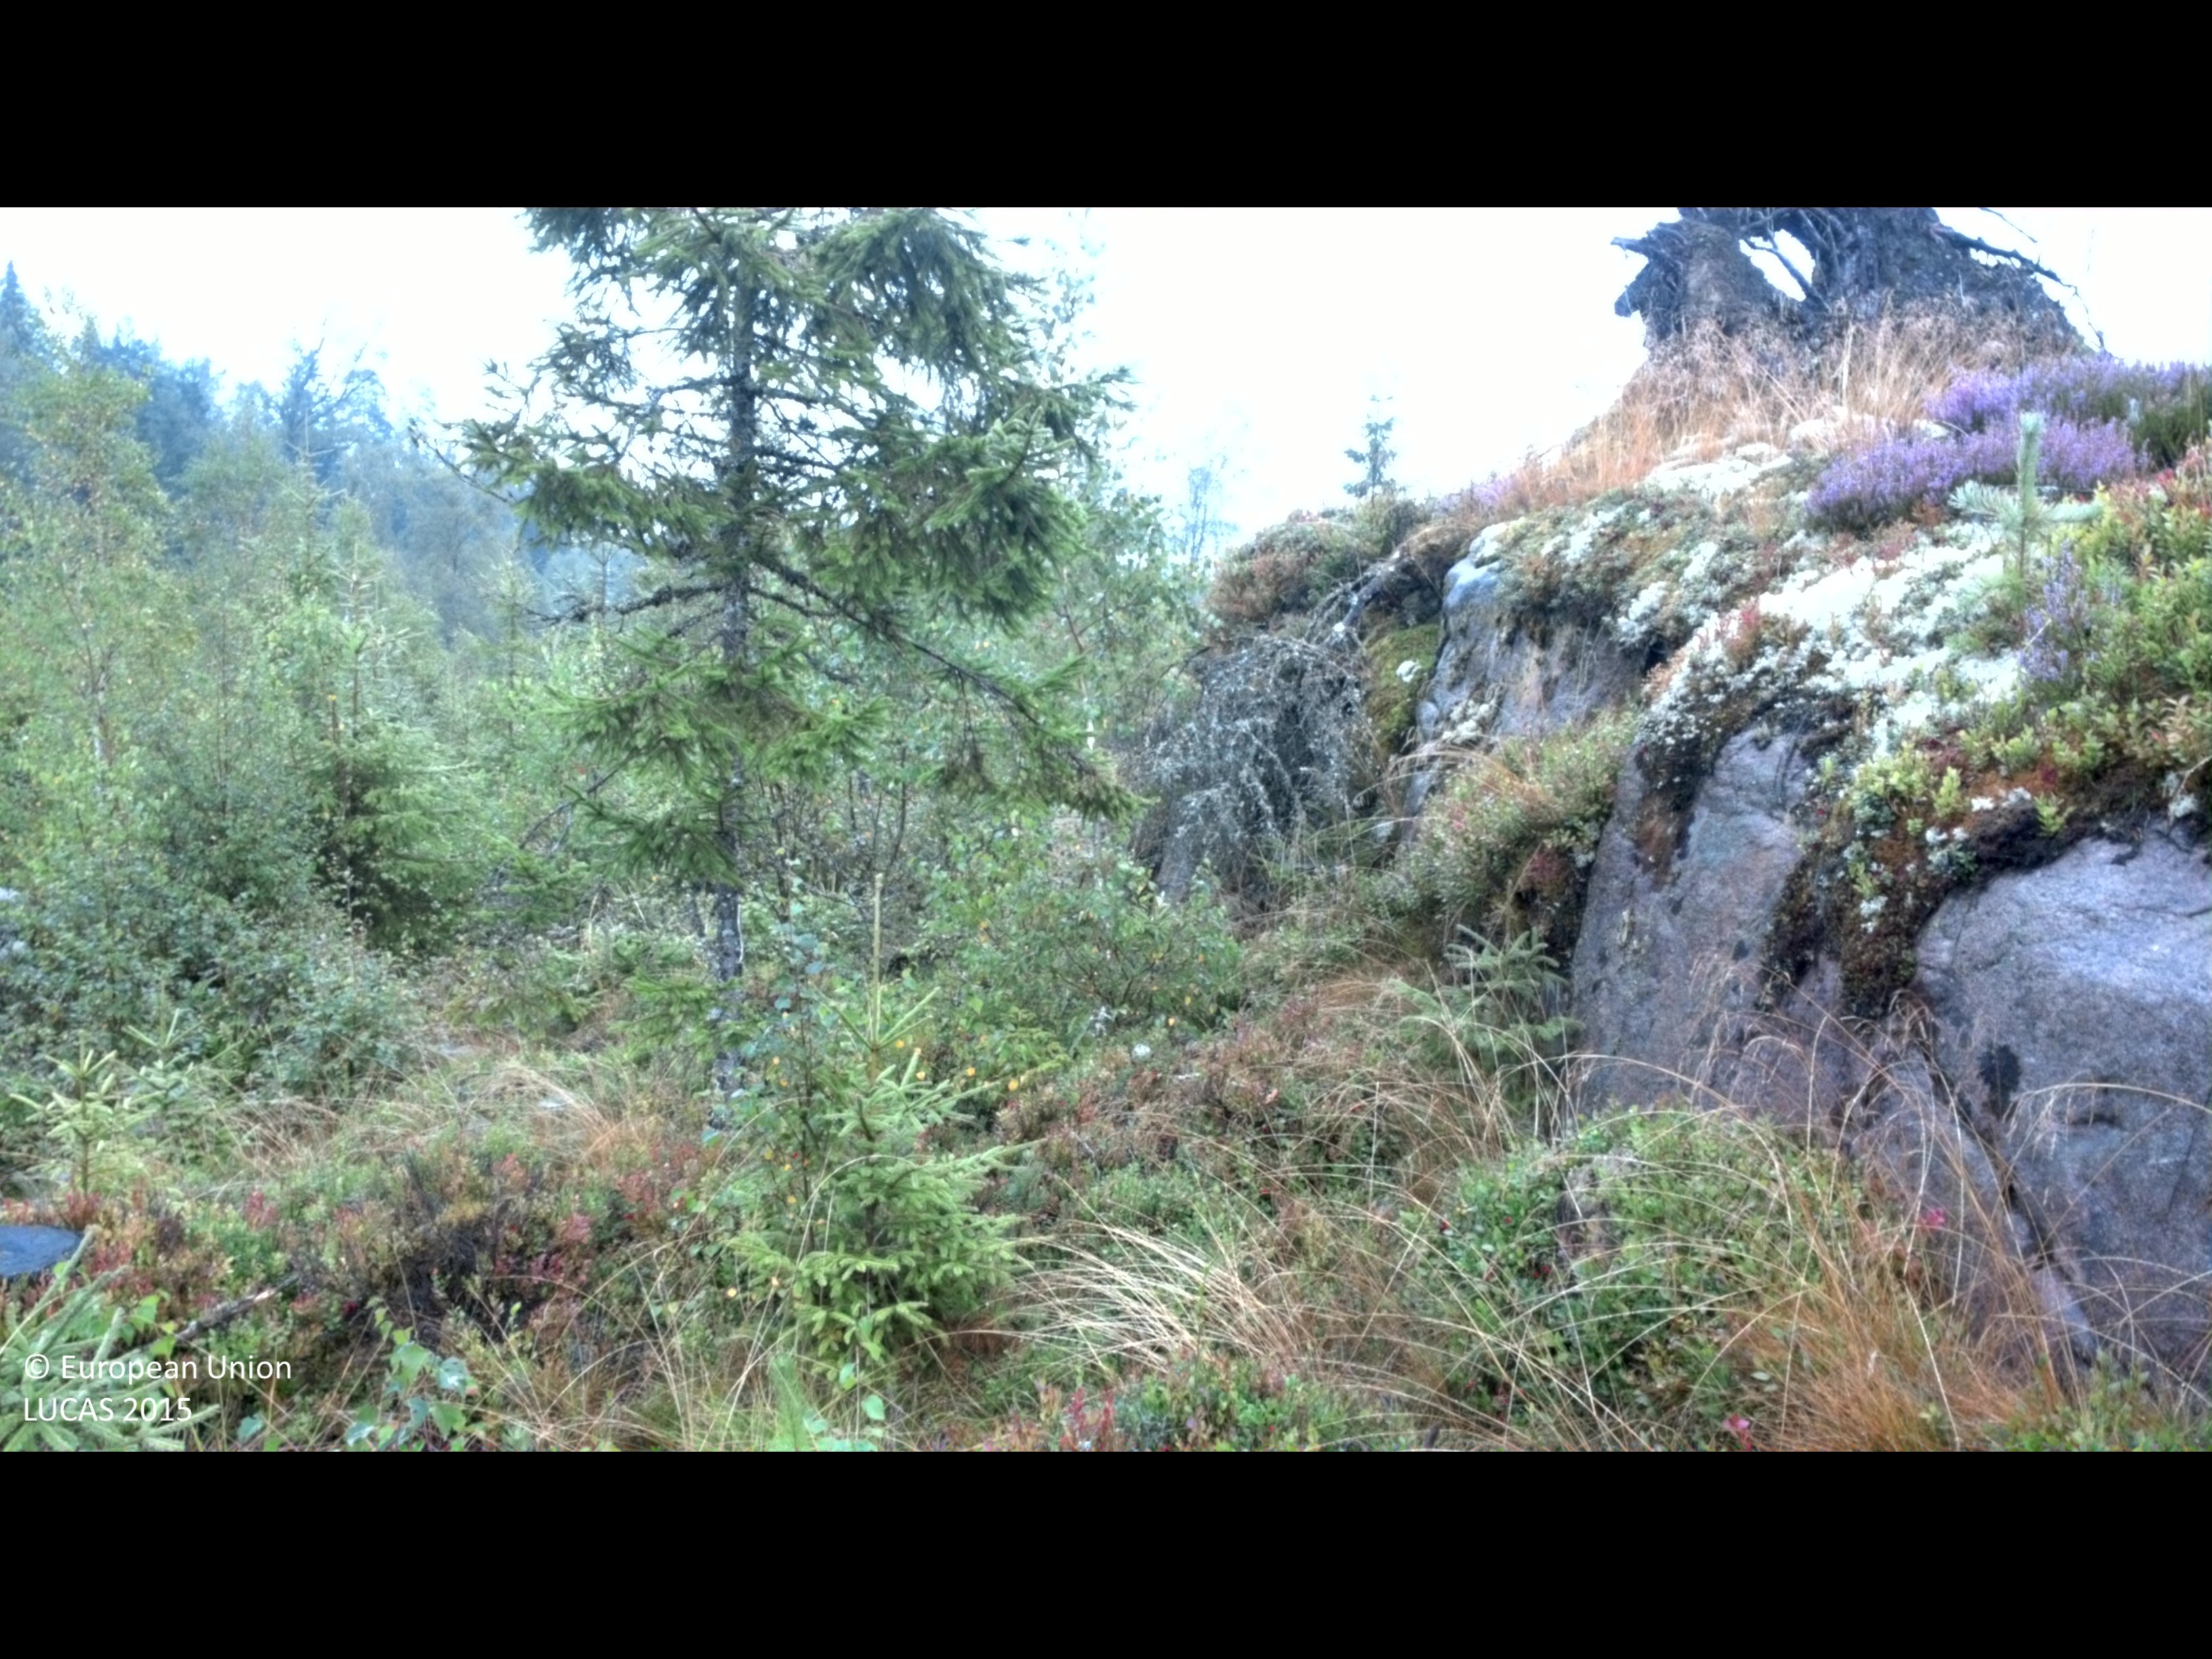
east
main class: Woodland
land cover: Spruce dominated mixed woodland
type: boreal forest
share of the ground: 10 - 25 %
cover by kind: shrubs 60 %, coniferous forest trees 15 %, broadleaved forest trees 10 %, herbaceous plants 10 %, lichens and mosses 5 %
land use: Forestry
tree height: < 5 m
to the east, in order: Spruce dominated mixed woodland; Tracks; Spruce dominated mixed woodland; Ditches and canals; Spruce dominated mixed woodland; Spruce dominated coniferous woodland; Paved roads, cycling and walking lanes; Pine dominated coniferous woodland; Spruce dominated coniferous woodland; Tracks; Spruce dominated mixed woodland; Spruce dominated coniferous woodland
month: September
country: SE
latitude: 57.3885
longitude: 13.9053
